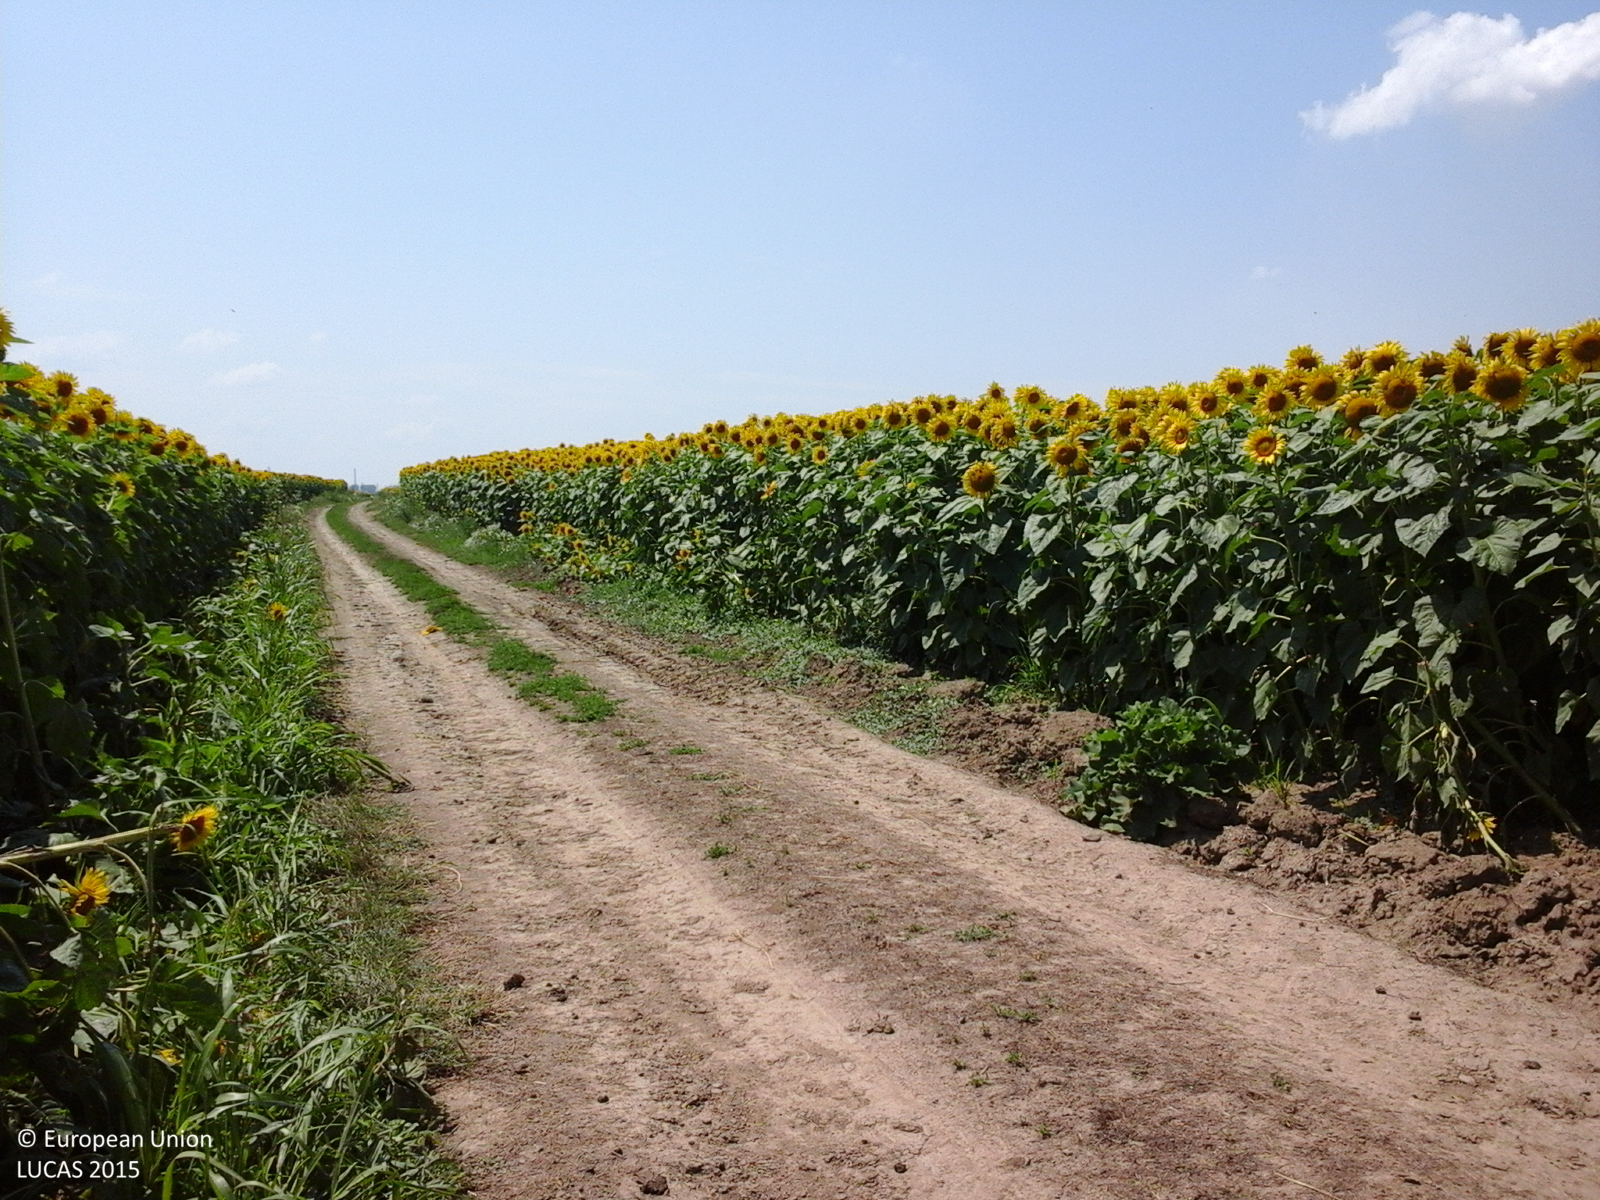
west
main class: Cropland
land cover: Sunflower
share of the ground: > 75 %
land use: Agriculture (excluding fallow land and kitchen gardens)
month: July
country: RO
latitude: 43.6485
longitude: 25.4176
